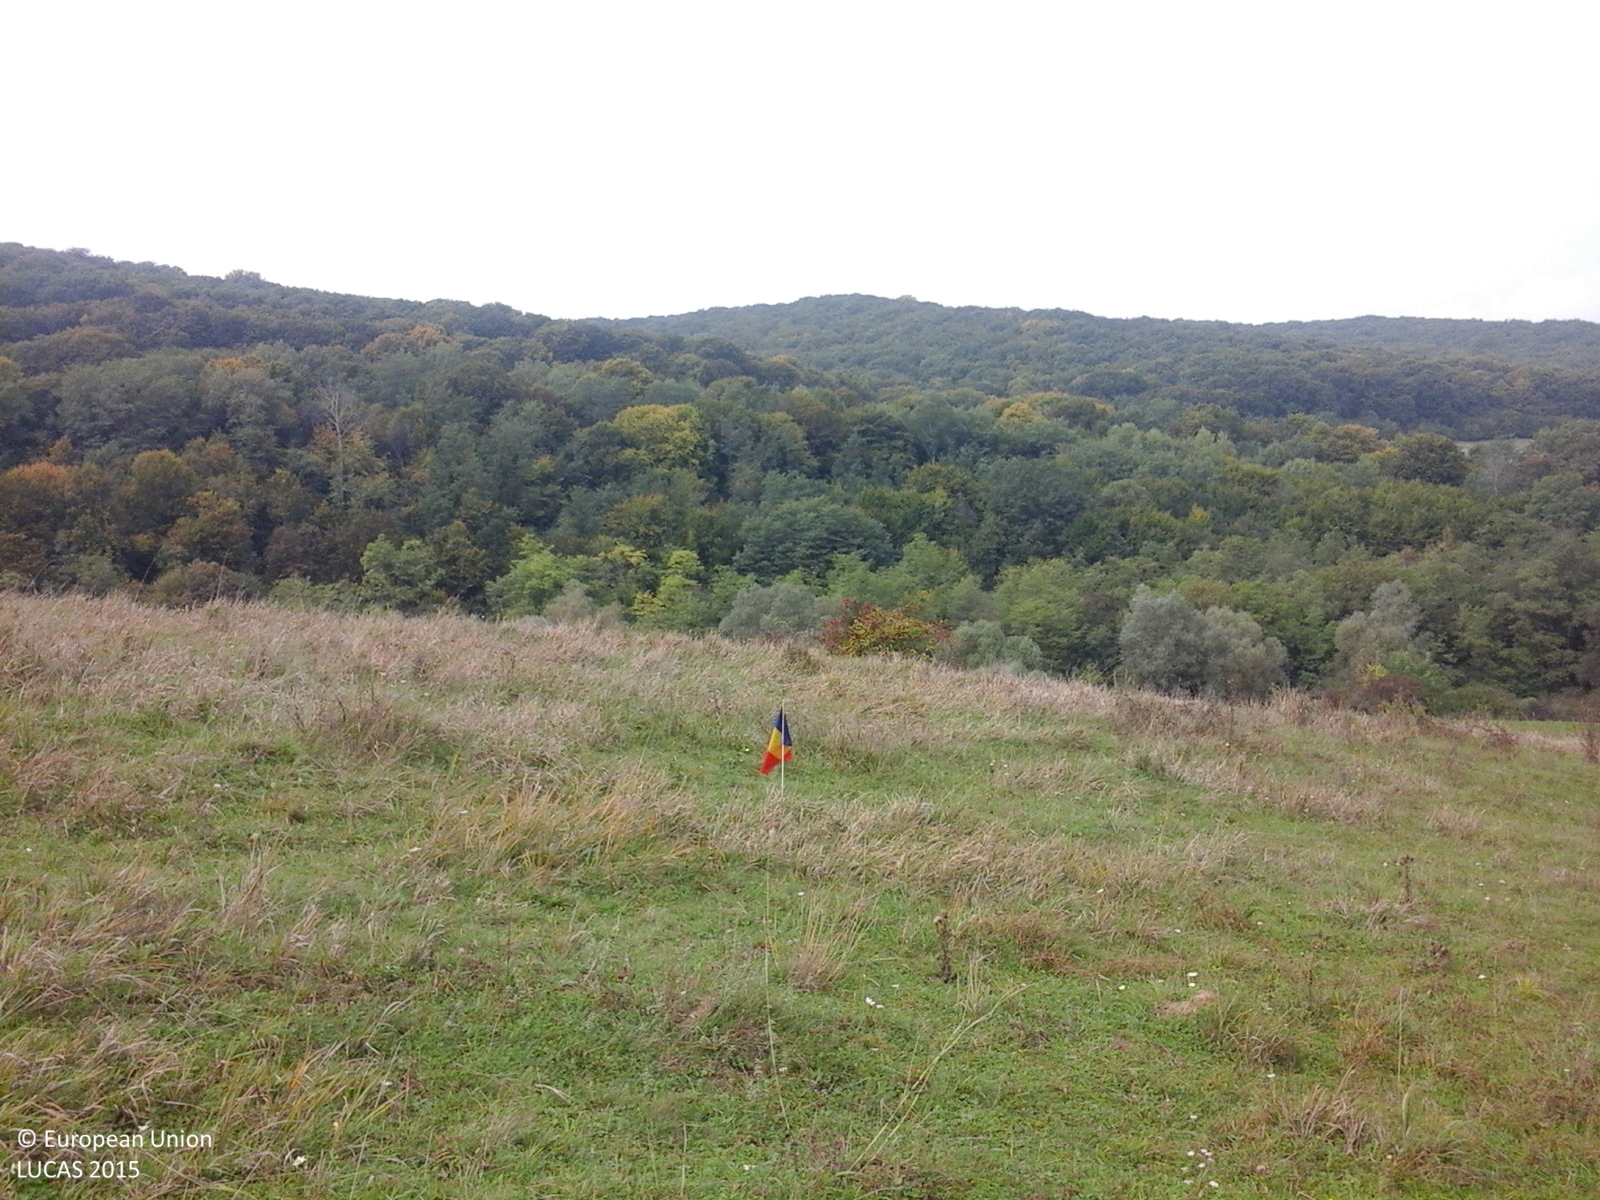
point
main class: Grassland
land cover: Grassland without tree/shrub cover
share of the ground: > 75 %
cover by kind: herbaceous plants 100 %
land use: Agriculture (excluding fallow land and kitchen gardens)
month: October
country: RO
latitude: 46.2991
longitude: 24.6948
